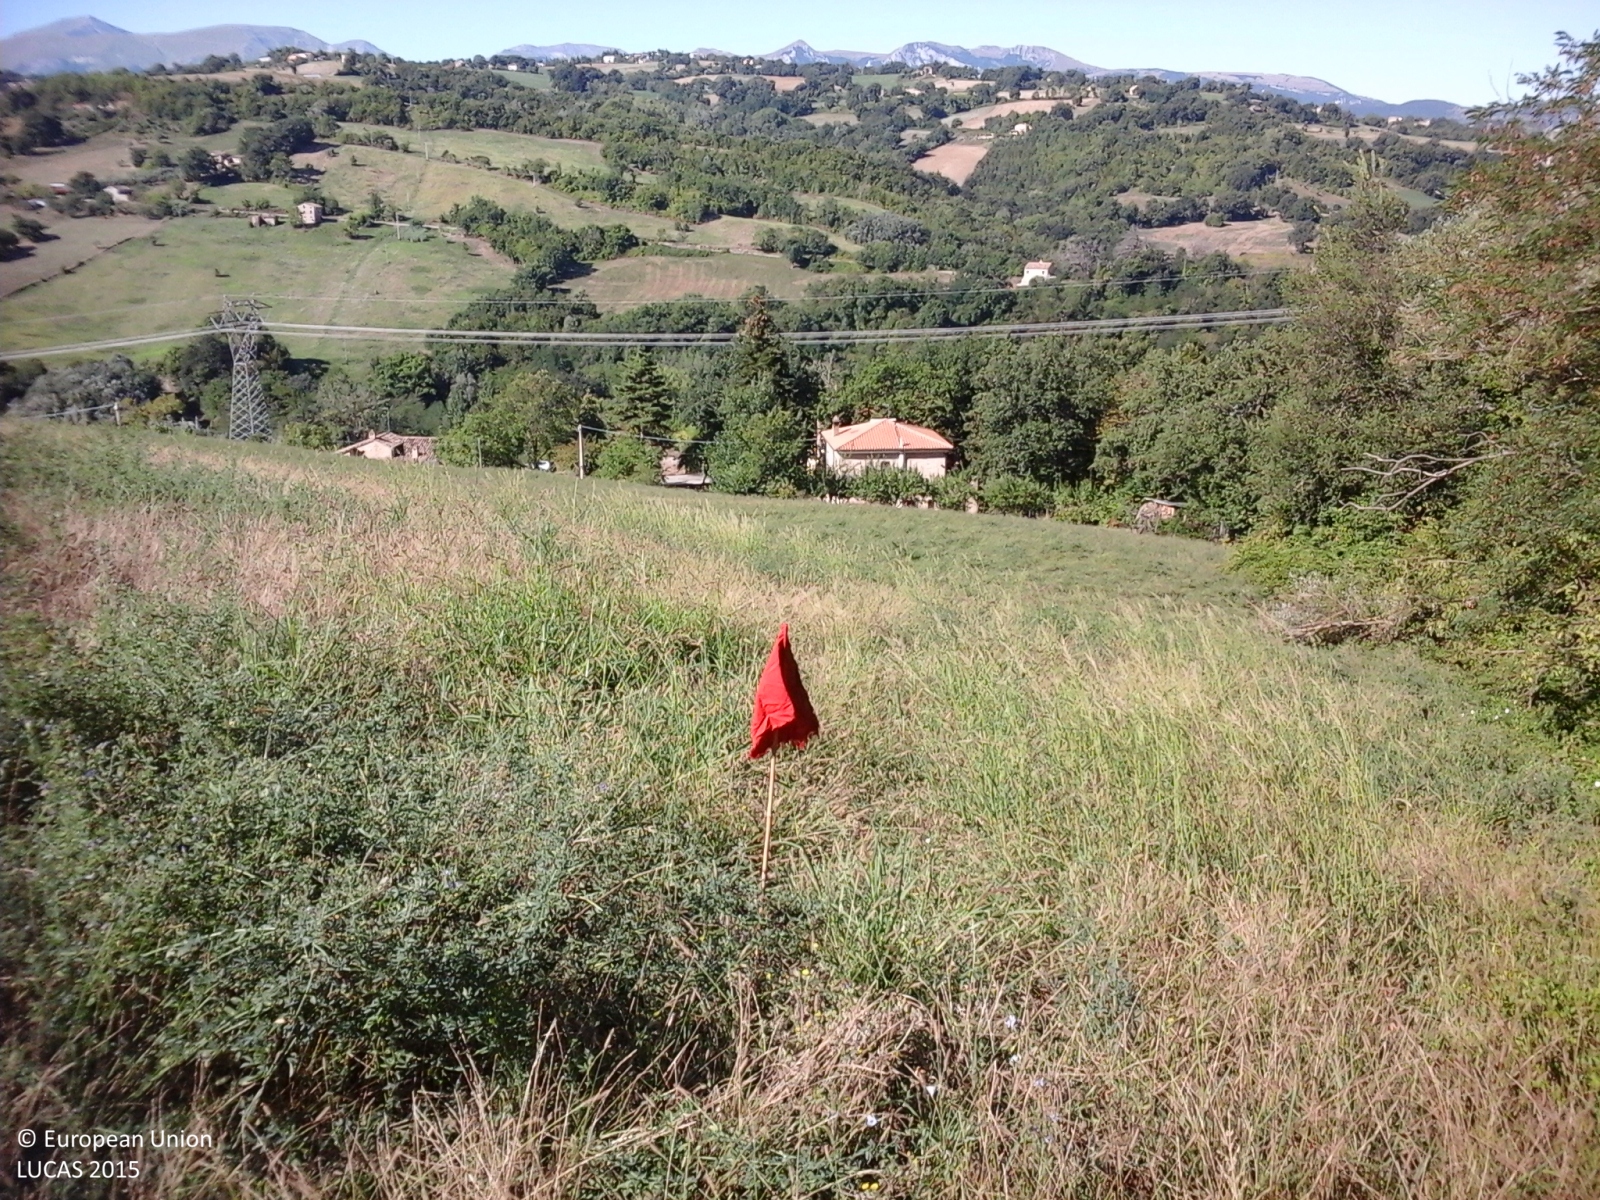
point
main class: Cropland
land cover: Lucerne
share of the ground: > 75 %
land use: Agriculture (excluding fallow land and kitchen gardens)
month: August
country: IT
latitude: 43.0859
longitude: 13.3689
